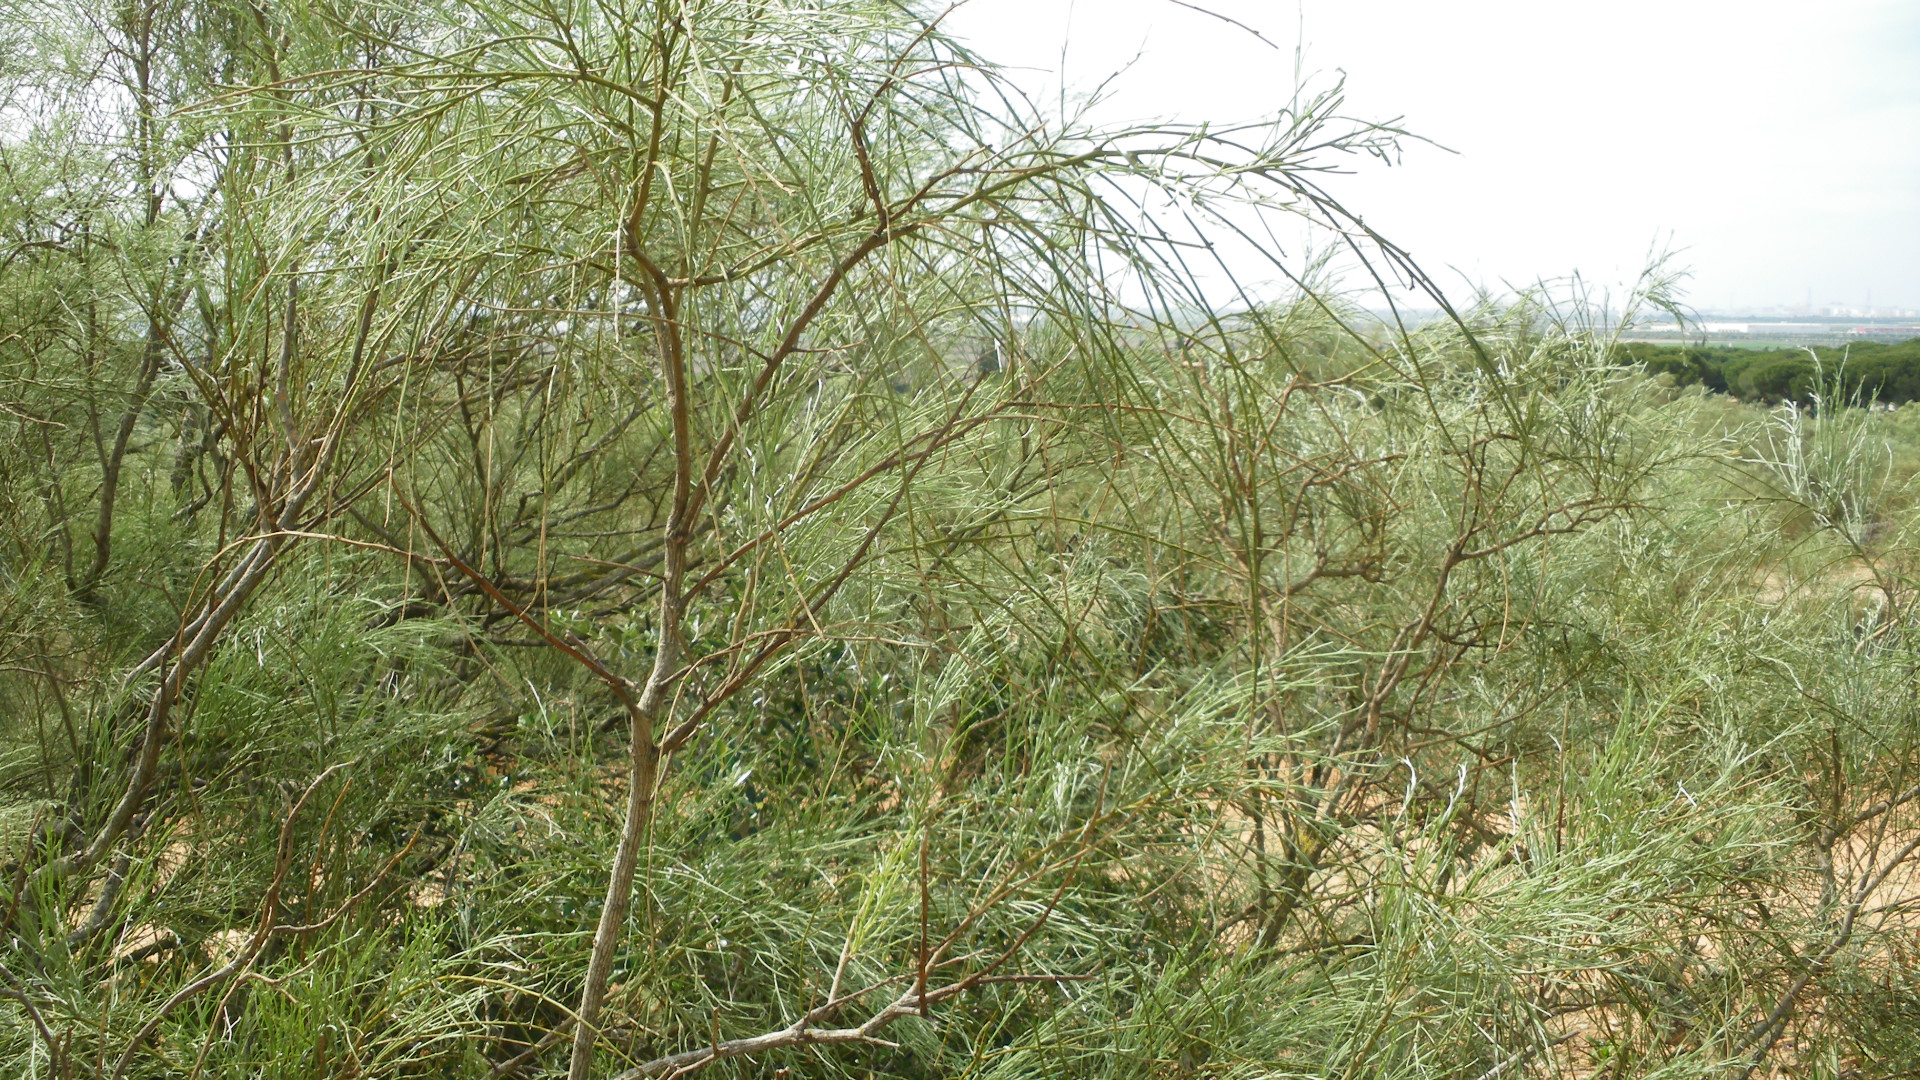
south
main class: Shrubland
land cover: Shrubland without tree cover
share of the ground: 25 - 50 %
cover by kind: shrubs 50 %, consolidated bare surface 30 %, herbaceous plants 20 %
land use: Semi-natural and natural areas not in use
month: April
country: ES
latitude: 36.6303
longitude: -6.1713
